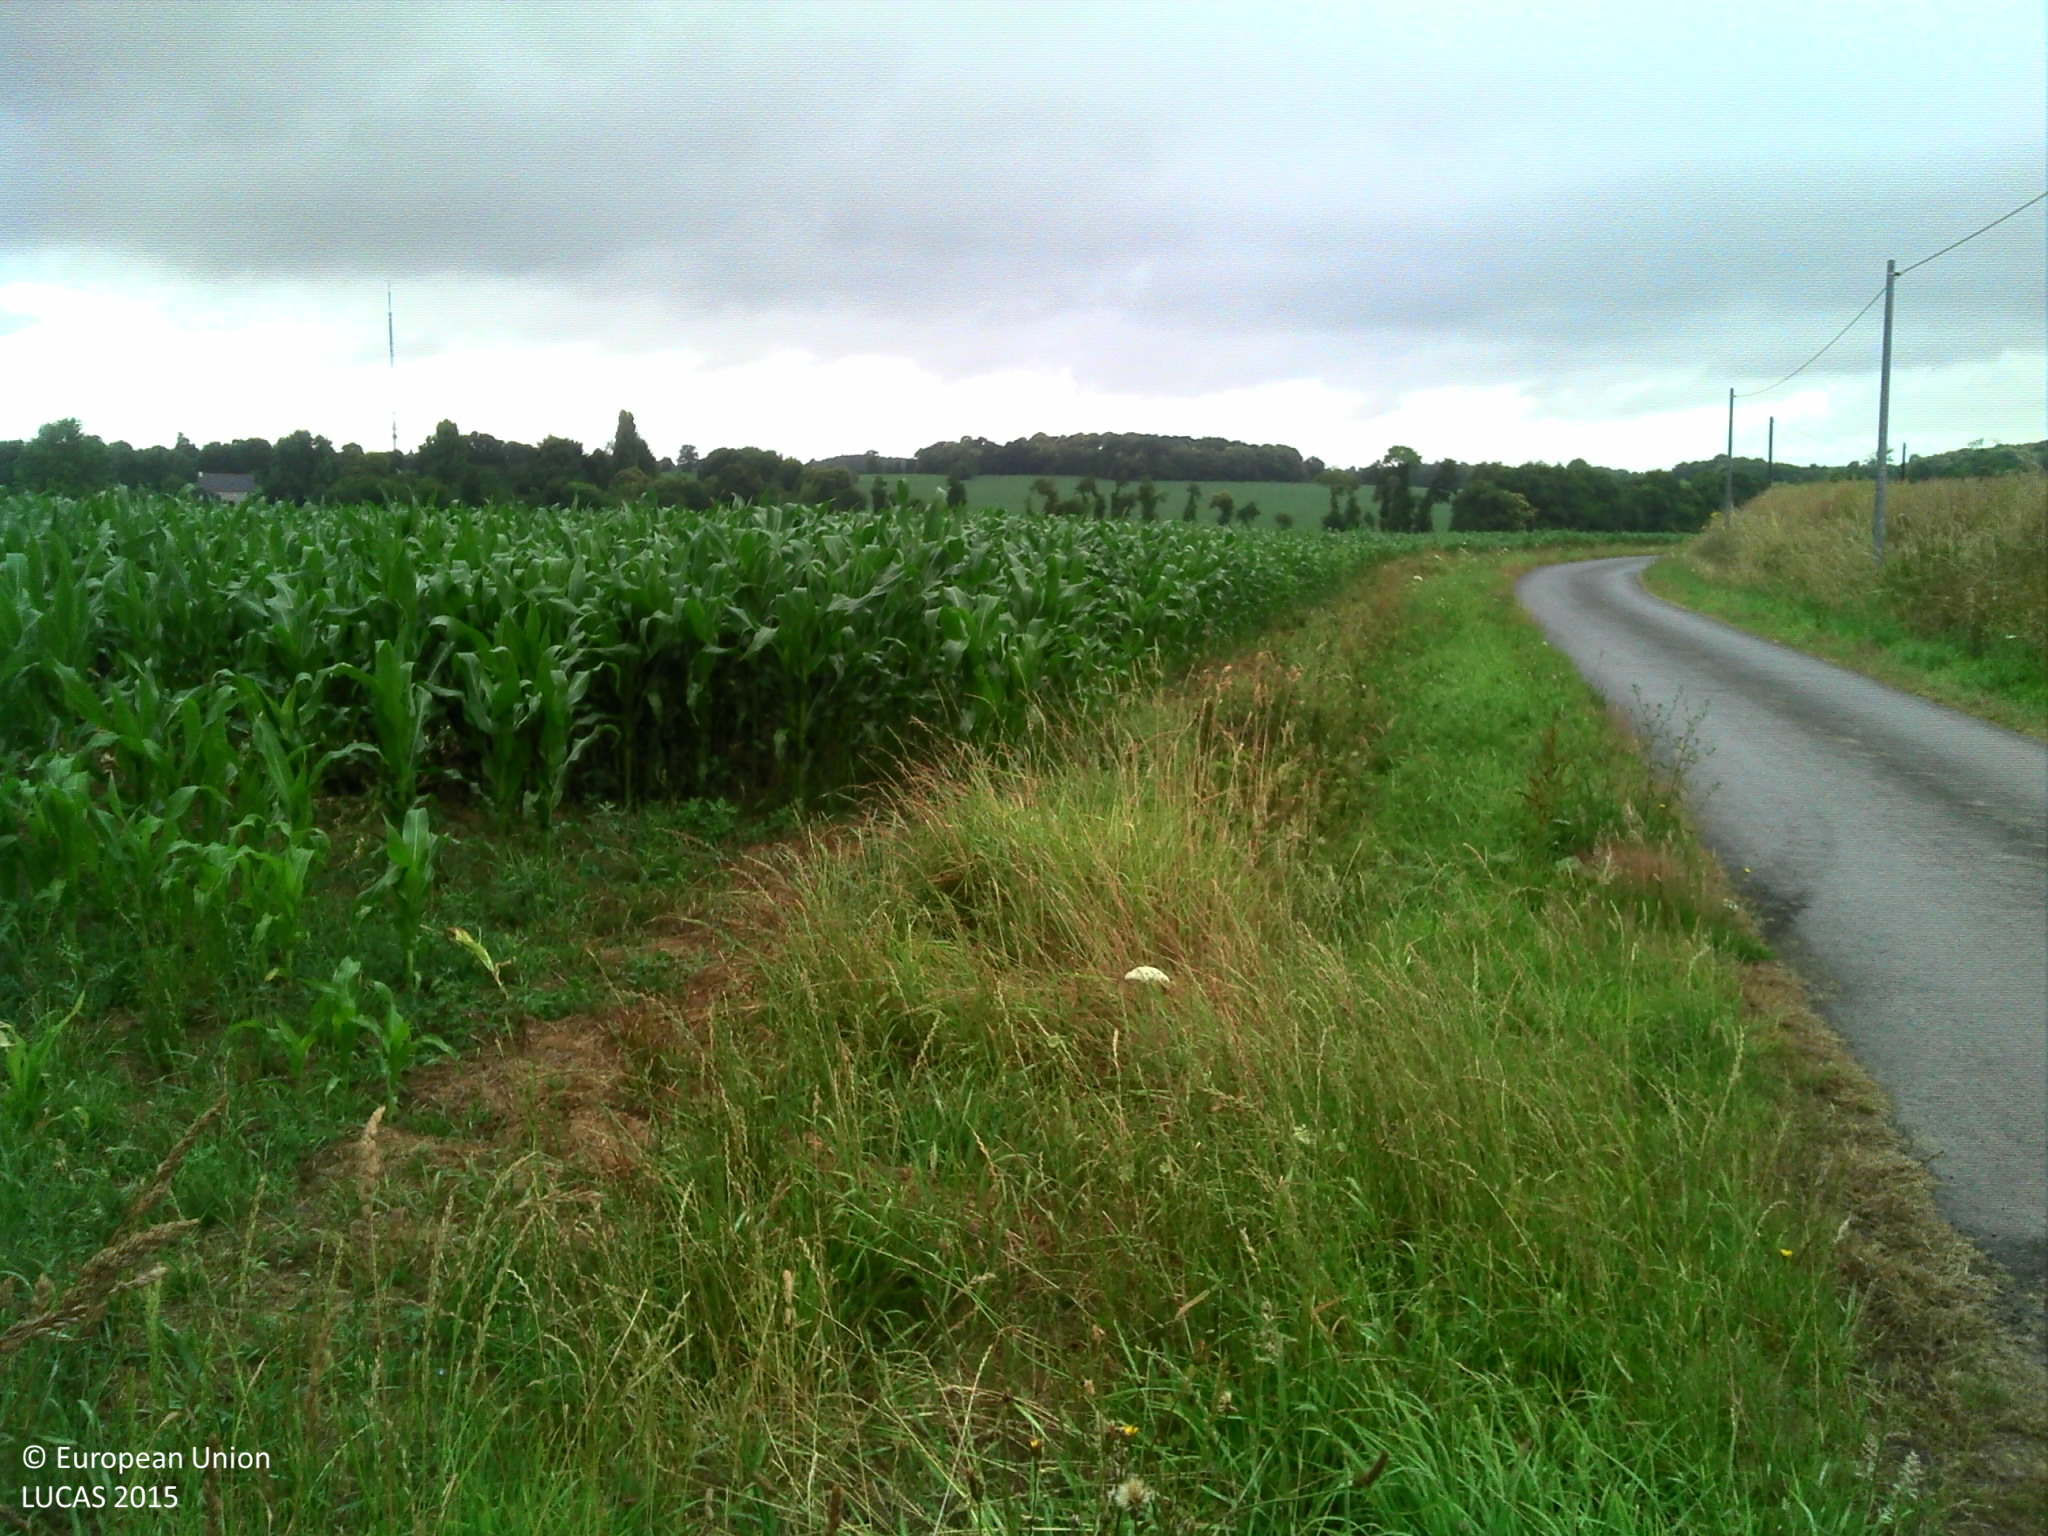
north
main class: Grassland
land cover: Grassland without tree/shrub cover
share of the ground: > 75 %
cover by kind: herbaceous plants 100 %
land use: Agriculture (excluding fallow land and kitchen gardens)
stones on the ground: 10 - 25 %
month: July
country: FR
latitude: 48.2623
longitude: -1.9472
